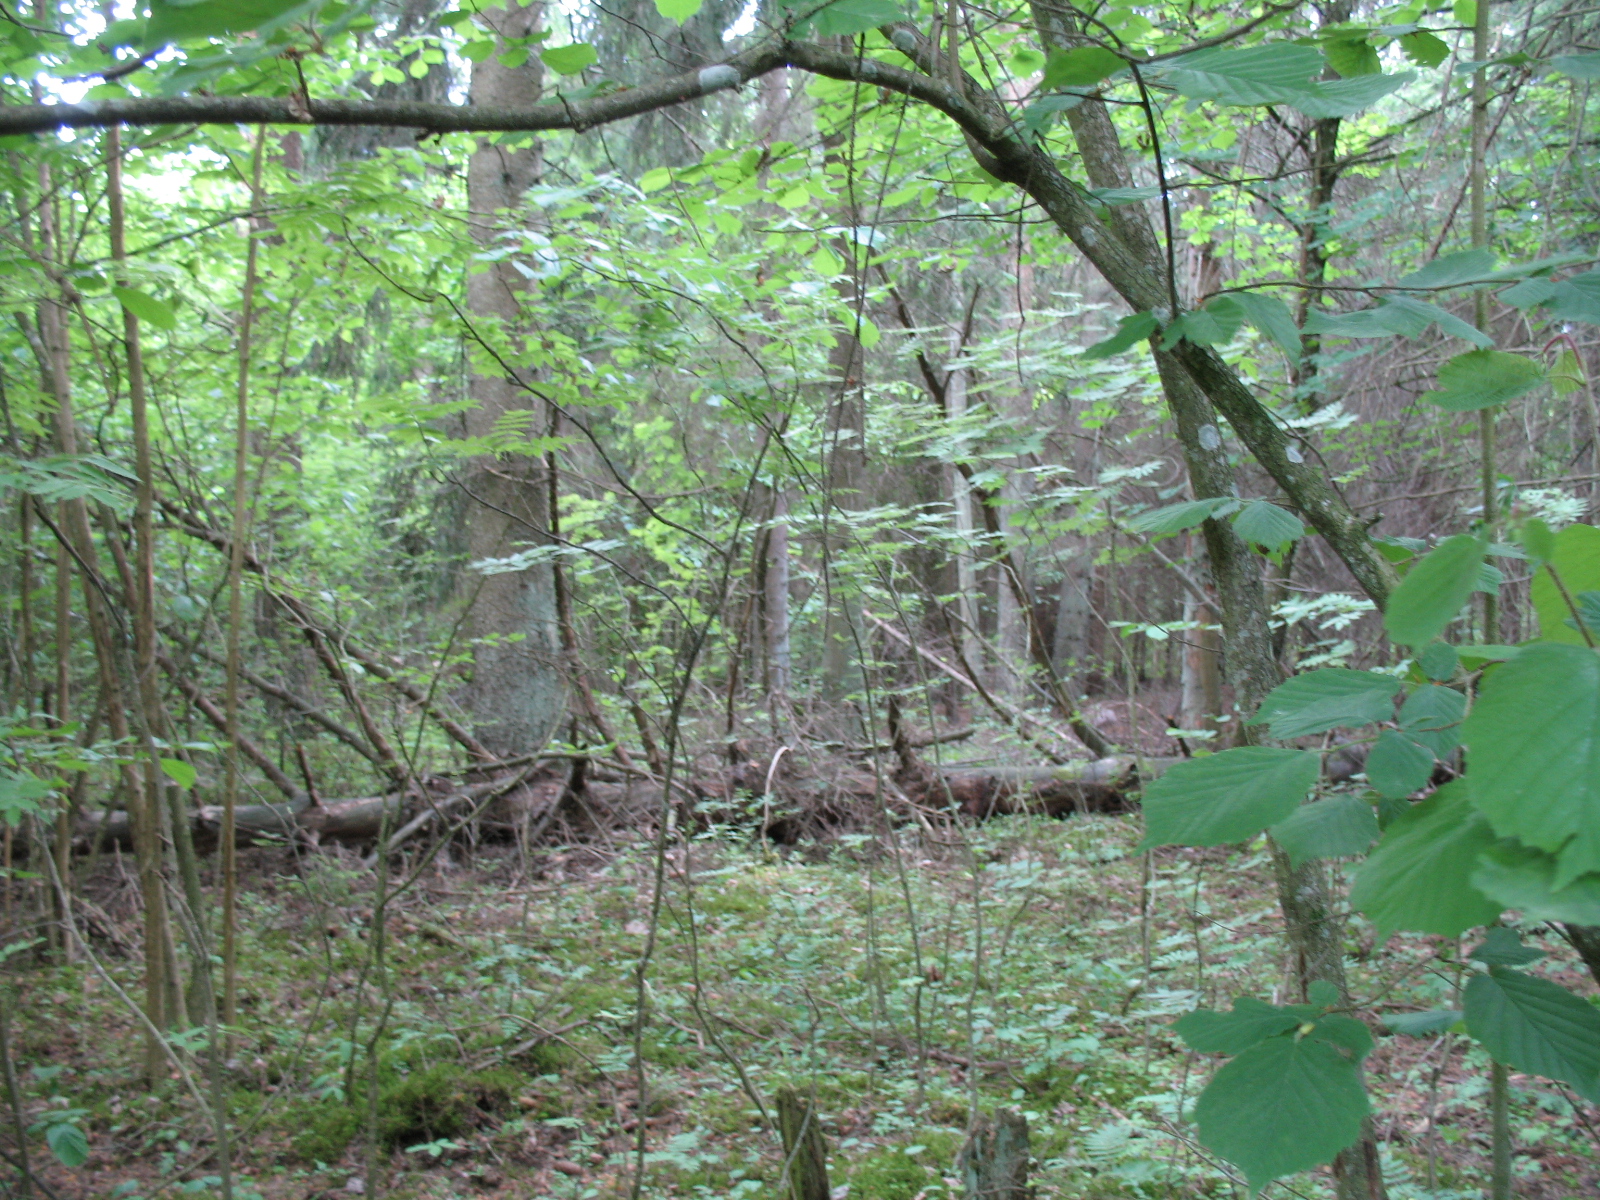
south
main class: Woodland
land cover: Spruce dominated coniferous woodland
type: hemiboreal forest and nemoral coniferous forest and mixed broadleaved-coniferous forest
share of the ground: > 75 %
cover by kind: coniferous forest trees 90 %, shrubs 10 %
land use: Forestry
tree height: > 5 m
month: June
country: LV
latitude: 56.4281
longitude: 23.4185
